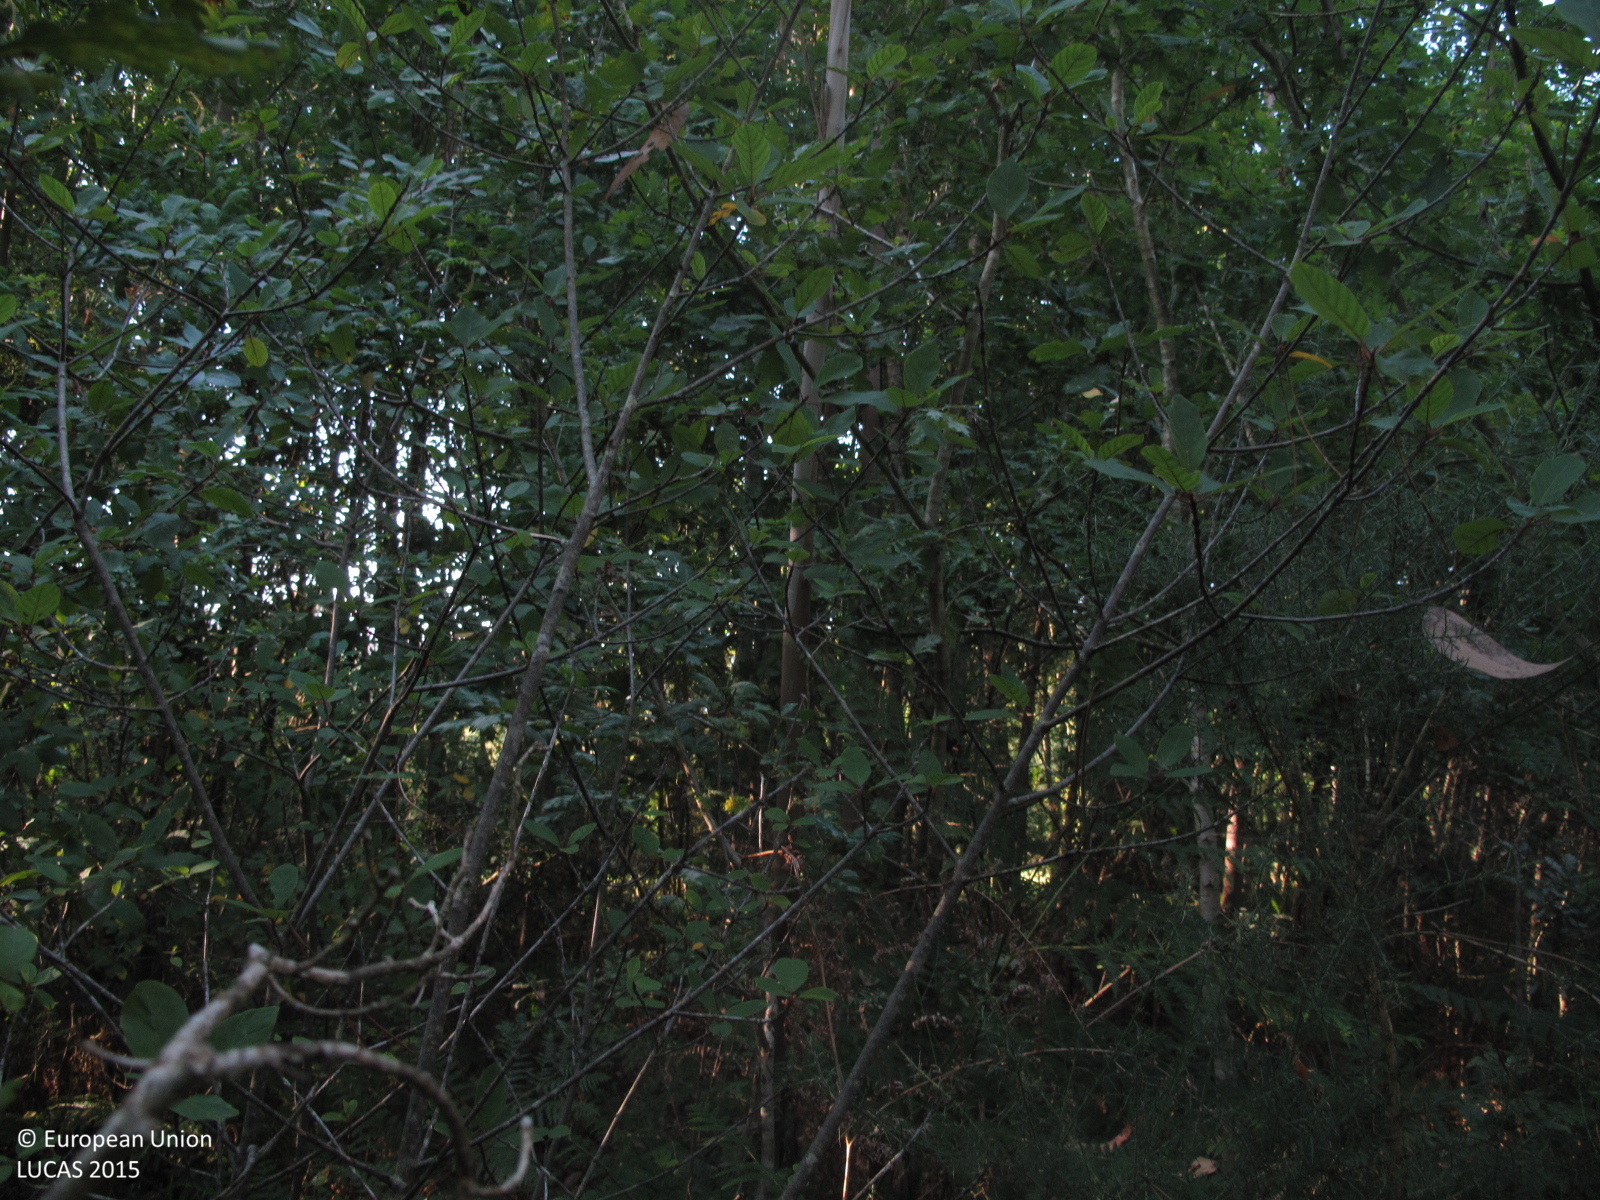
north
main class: Woodland
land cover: Broadleaved woodland
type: acidophilous oak and oak-birch forest
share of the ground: > 75 %
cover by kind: broadleaved forest trees 90 %, shrubs 5 %, herbaceous plants 5 %
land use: Forestry
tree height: > 5 m
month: July
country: ES
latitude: 43.3255
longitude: -8.0382
